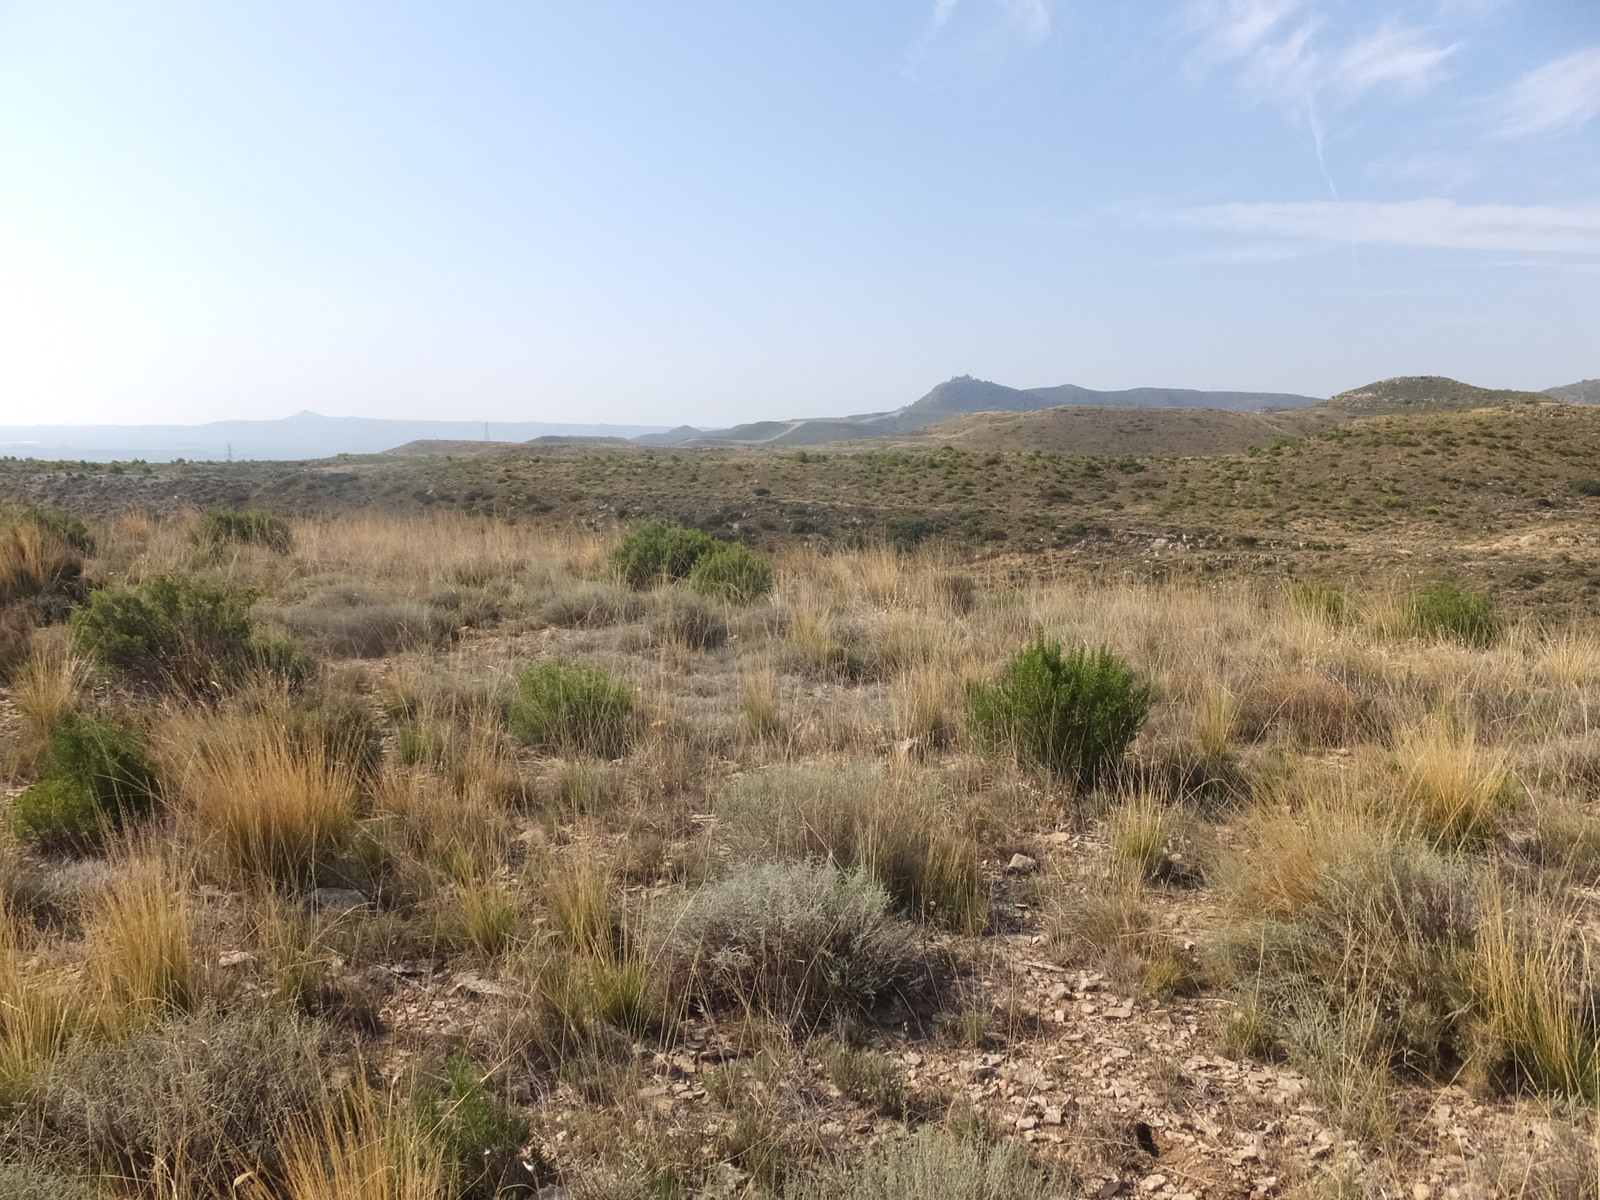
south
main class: Shrubland
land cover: Shrubland without tree cover
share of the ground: > 75 %
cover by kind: shrubs 60 %, herbaceous plants 25 %, consolidated bare surface 15 %
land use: Semi-natural and natural areas not in use
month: August
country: ES
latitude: 41.4984
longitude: 0.3200
